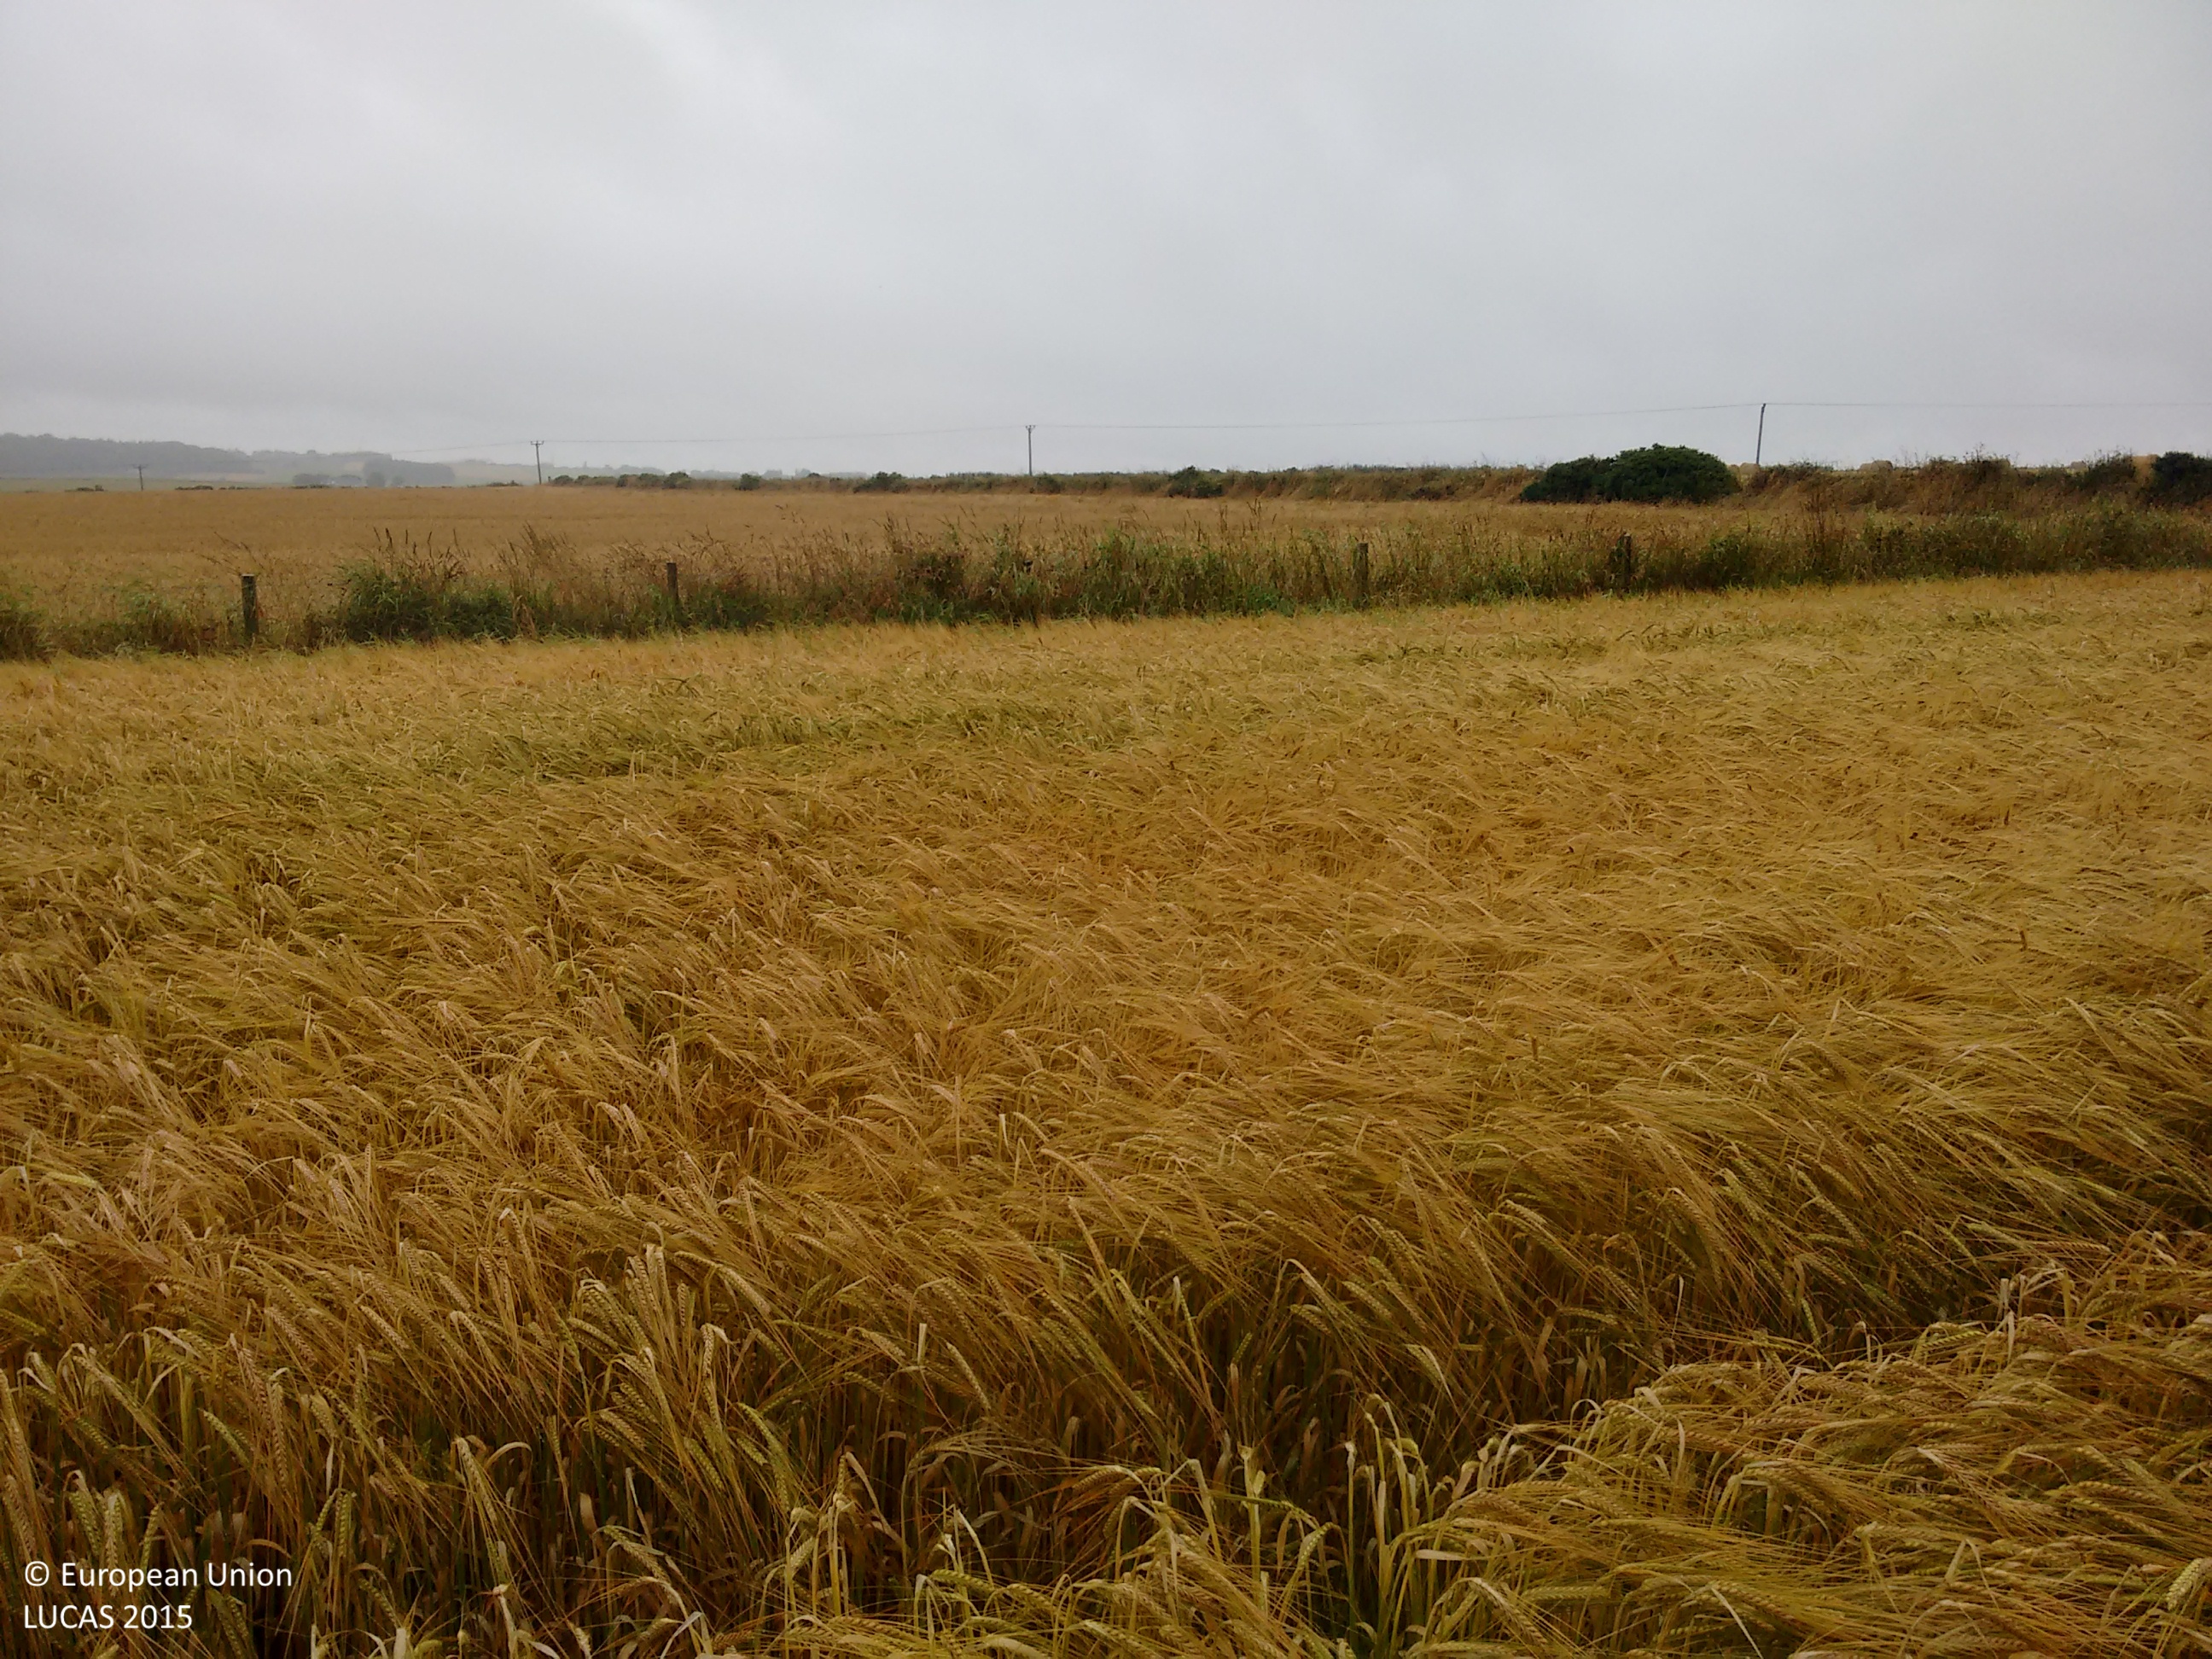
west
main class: Cropland
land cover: Barley
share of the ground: > 75 %
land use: Agriculture (excluding fallow land and kitchen gardens)
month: August
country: GB
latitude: 57.3047
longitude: -2.1149
